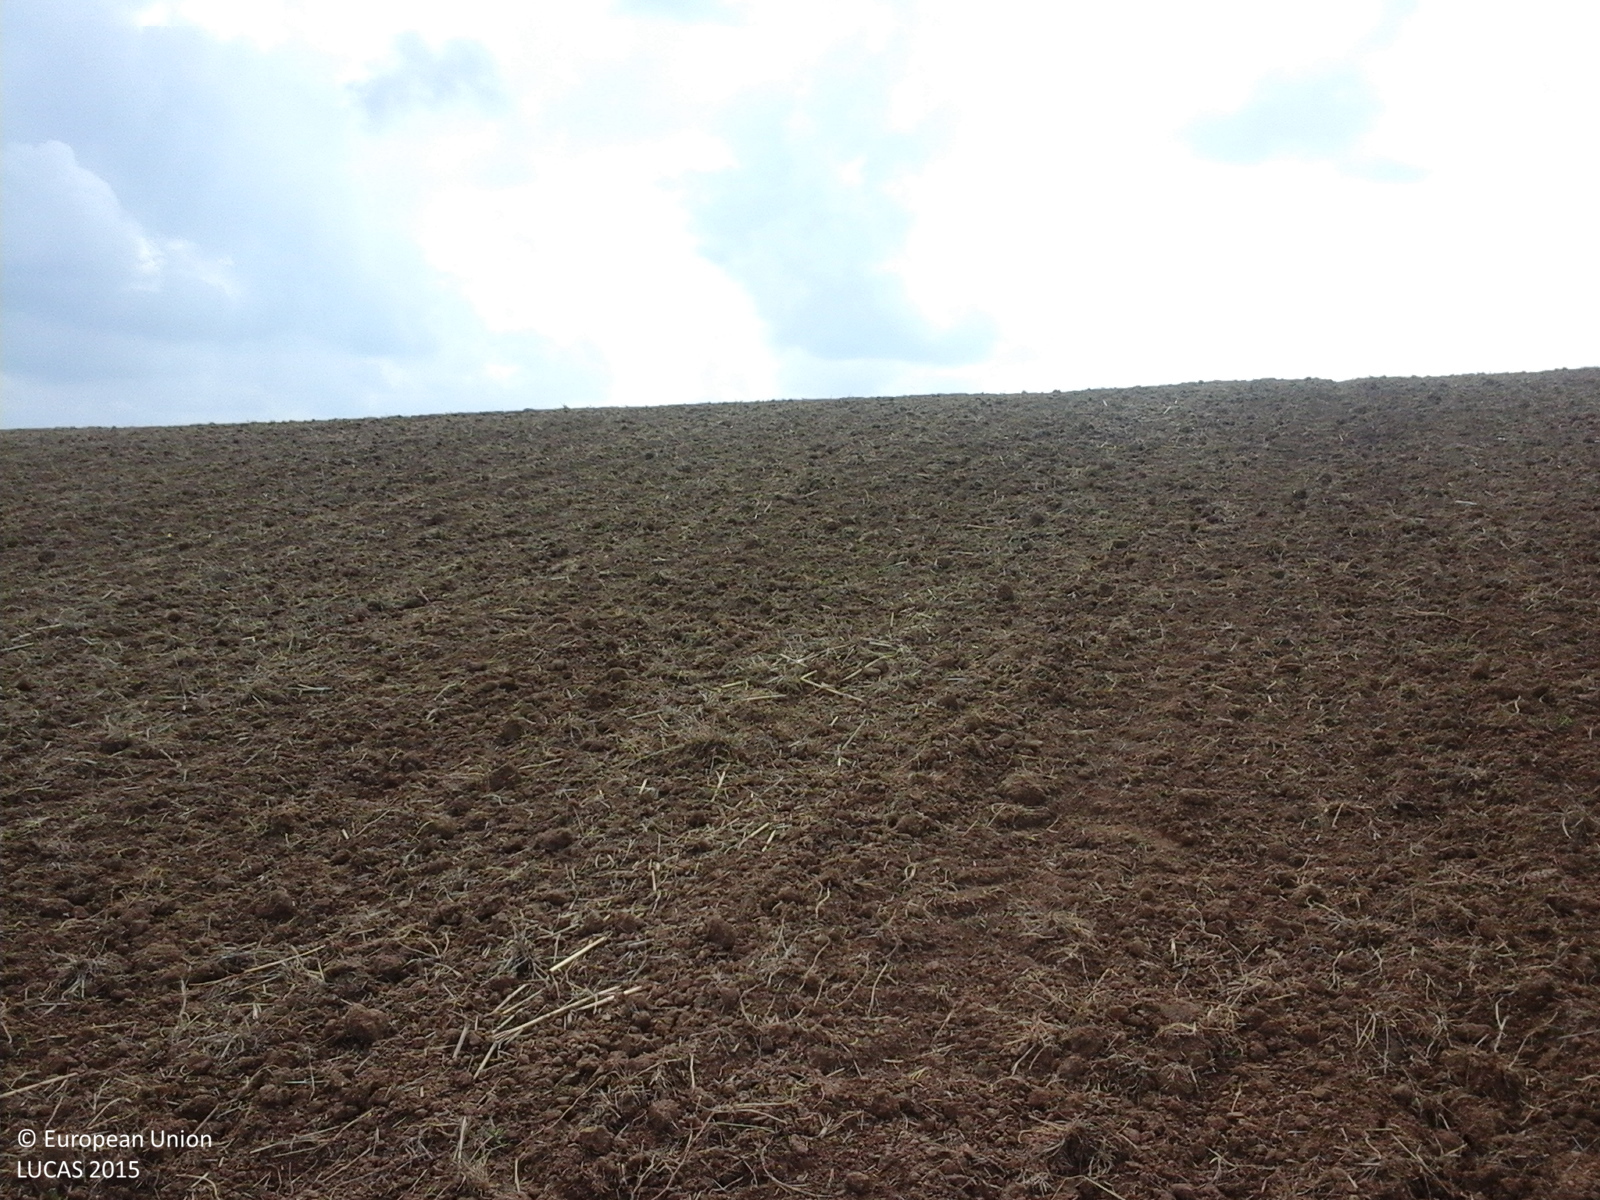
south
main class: Cropland
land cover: Maize
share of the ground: < 10 %
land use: Agriculture (excluding fallow land and kitchen gardens)
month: September
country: RO
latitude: 46.8770
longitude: 21.9731
